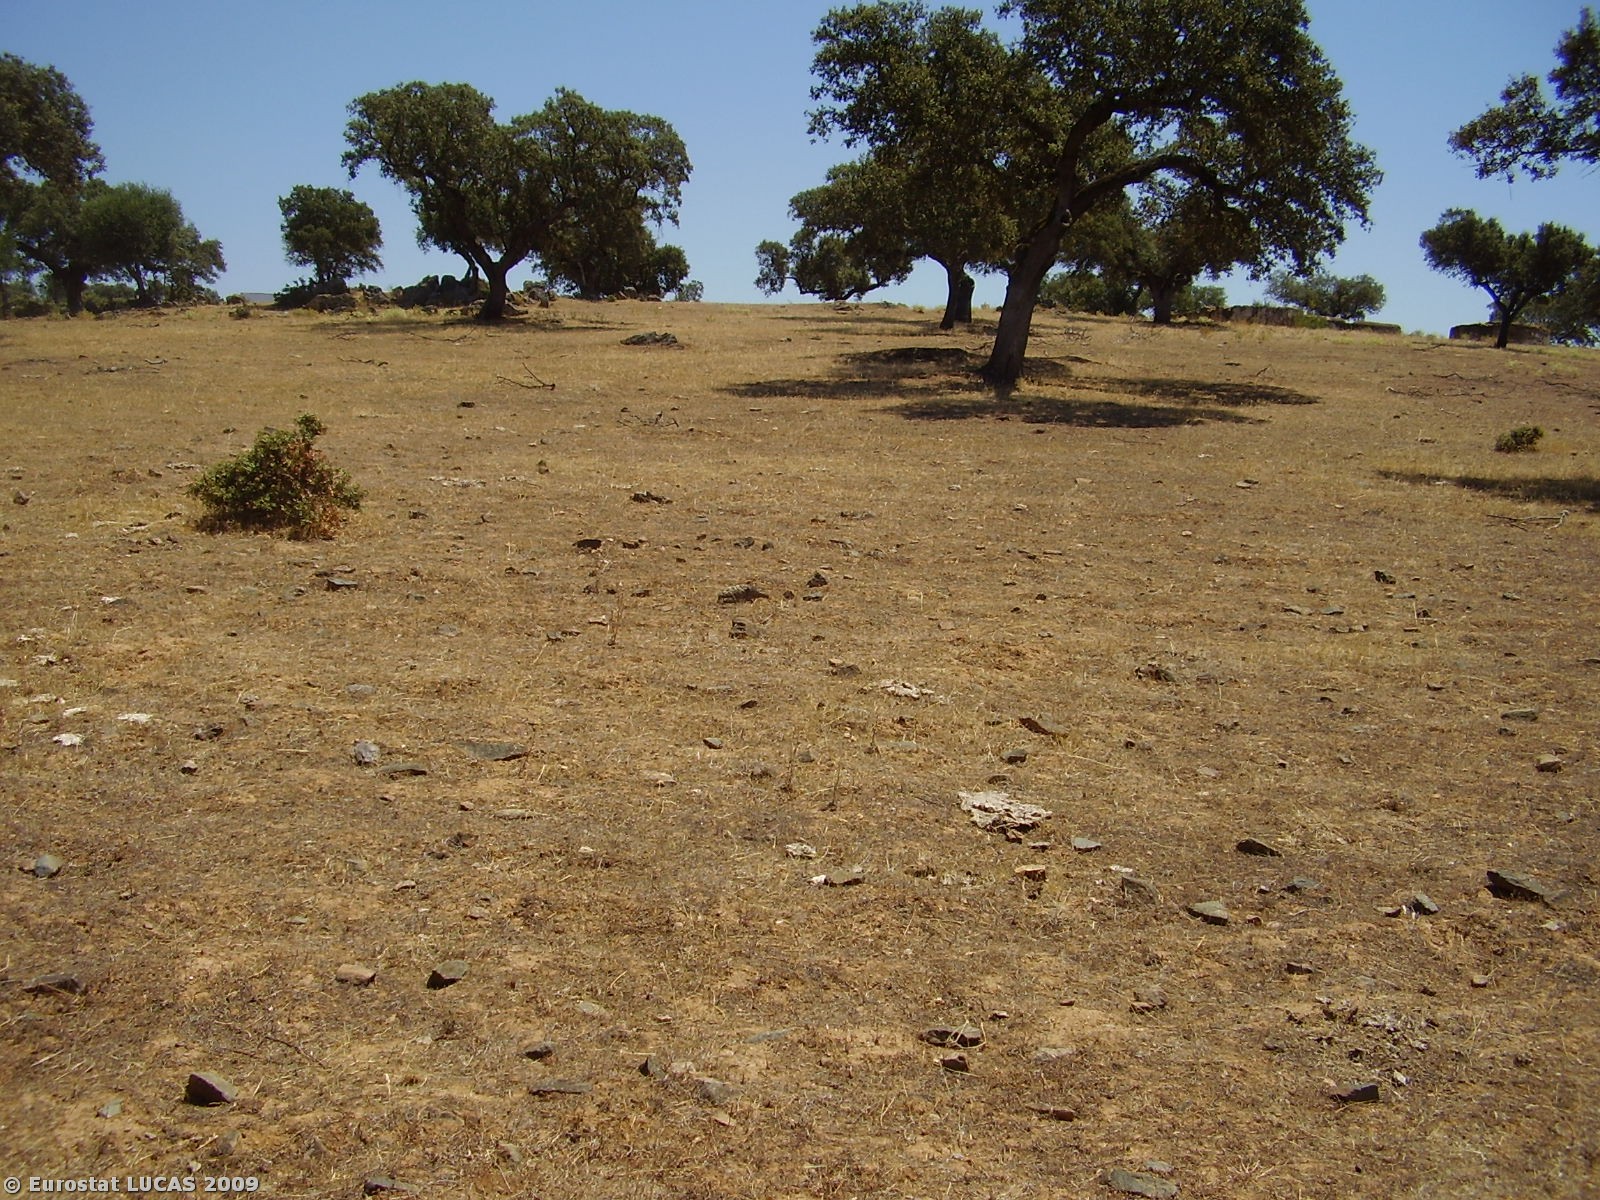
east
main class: Grassland
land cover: Grassland with sparse tree/shrub cover
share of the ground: > 75 %
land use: Fallow land
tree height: > 5 m
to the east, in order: Grassland with sparse tree/shrub cover; Broadleaved woodland; Rock outcrops; Broadleaved woodland; Rock outcrops; Shrubland without tree cover; Rivers and streams; Shrubland without tree cover; Rock outcrops; Broadleaved woodland; Rock outcrops; Lines of trees; Fences; Grassland without tree/shrub cover
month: July
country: PT
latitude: 38.8285
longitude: -7.2969
